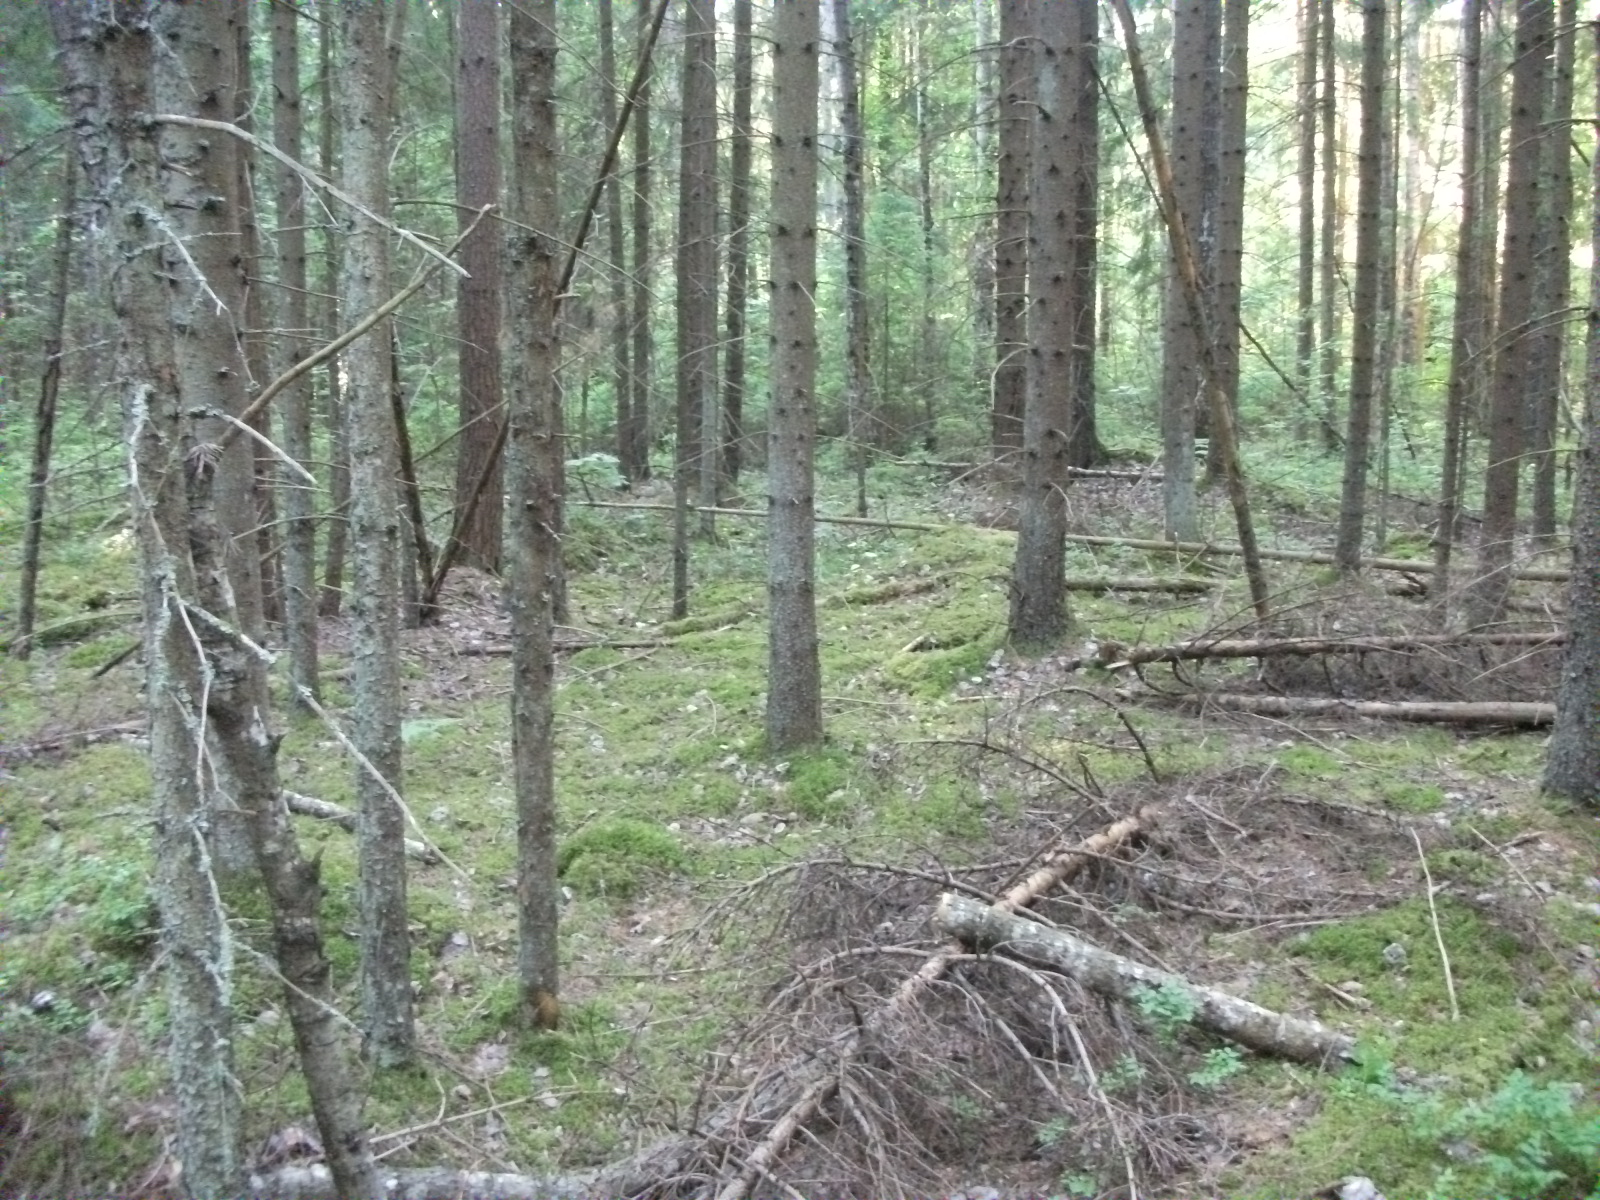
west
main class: Woodland
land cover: Spruce dominated coniferous woodland
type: hemiboreal forest and nemoral coniferous forest and mixed broadleaved-coniferous forest
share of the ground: > 75 %
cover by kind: coniferous forest trees 85 %, shrubs 10 %, broadleaved forest trees 5 %
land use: Forestry
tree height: > 5 m
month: July
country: LV
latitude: 56.8193
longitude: 26.6487
